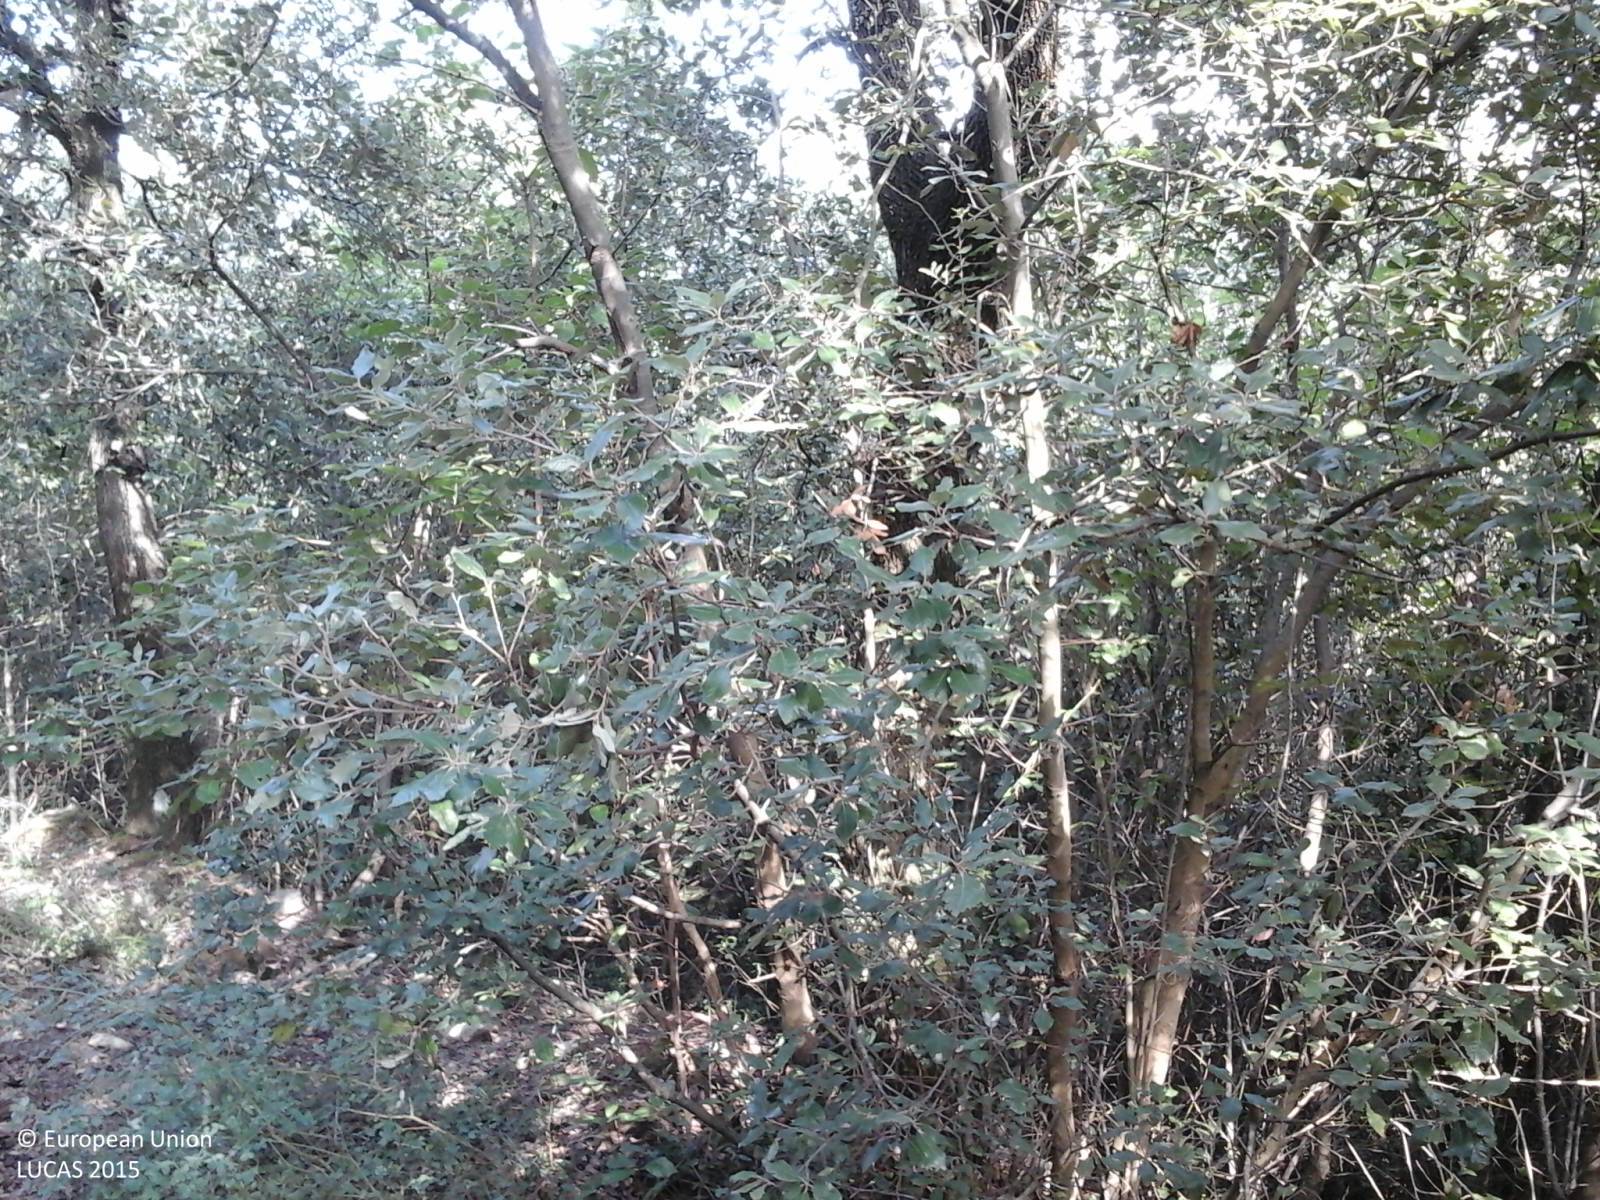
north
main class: Woodland
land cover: Broadleaved woodland
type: broadleaved evergreen forest
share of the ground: > 75 %
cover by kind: broadleaved forest trees 95 %, shrubs 5 %
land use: Forestry
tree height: > 5 m
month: October
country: IT
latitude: 42.6460
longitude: 12.2978
